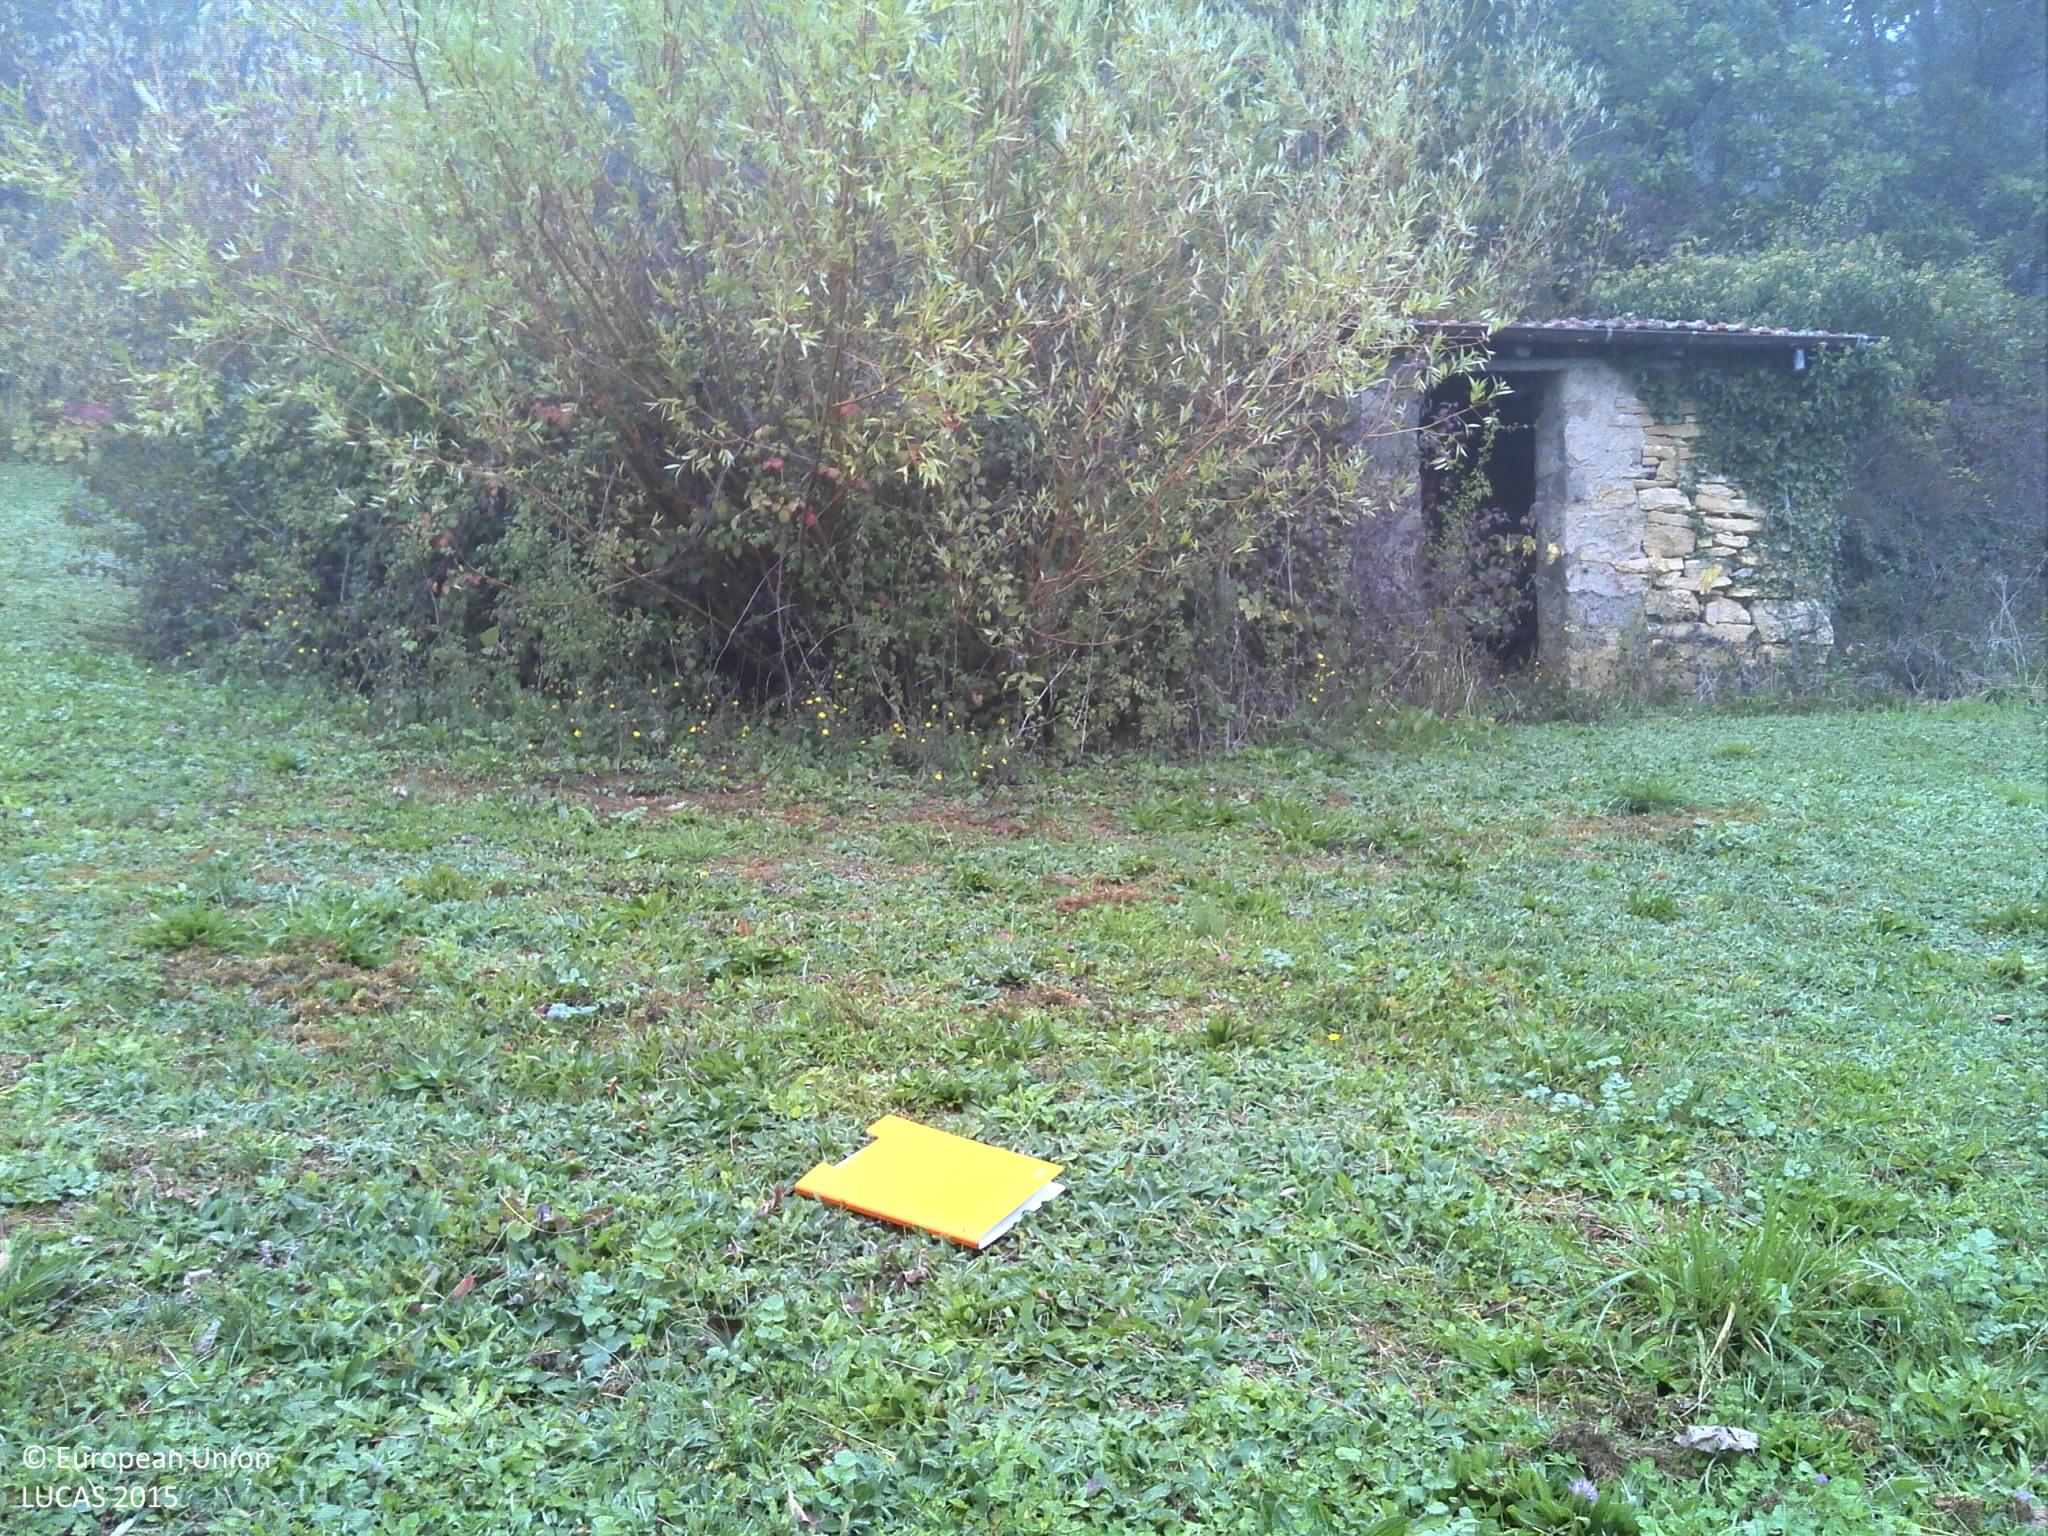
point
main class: Cropland
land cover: Apple fruit
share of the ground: 10 - 25 %
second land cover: Grassland without tree/shrub cover
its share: > 75 %
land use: Kitchen garden
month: October
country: FR
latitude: 46.3769
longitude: 5.3614
